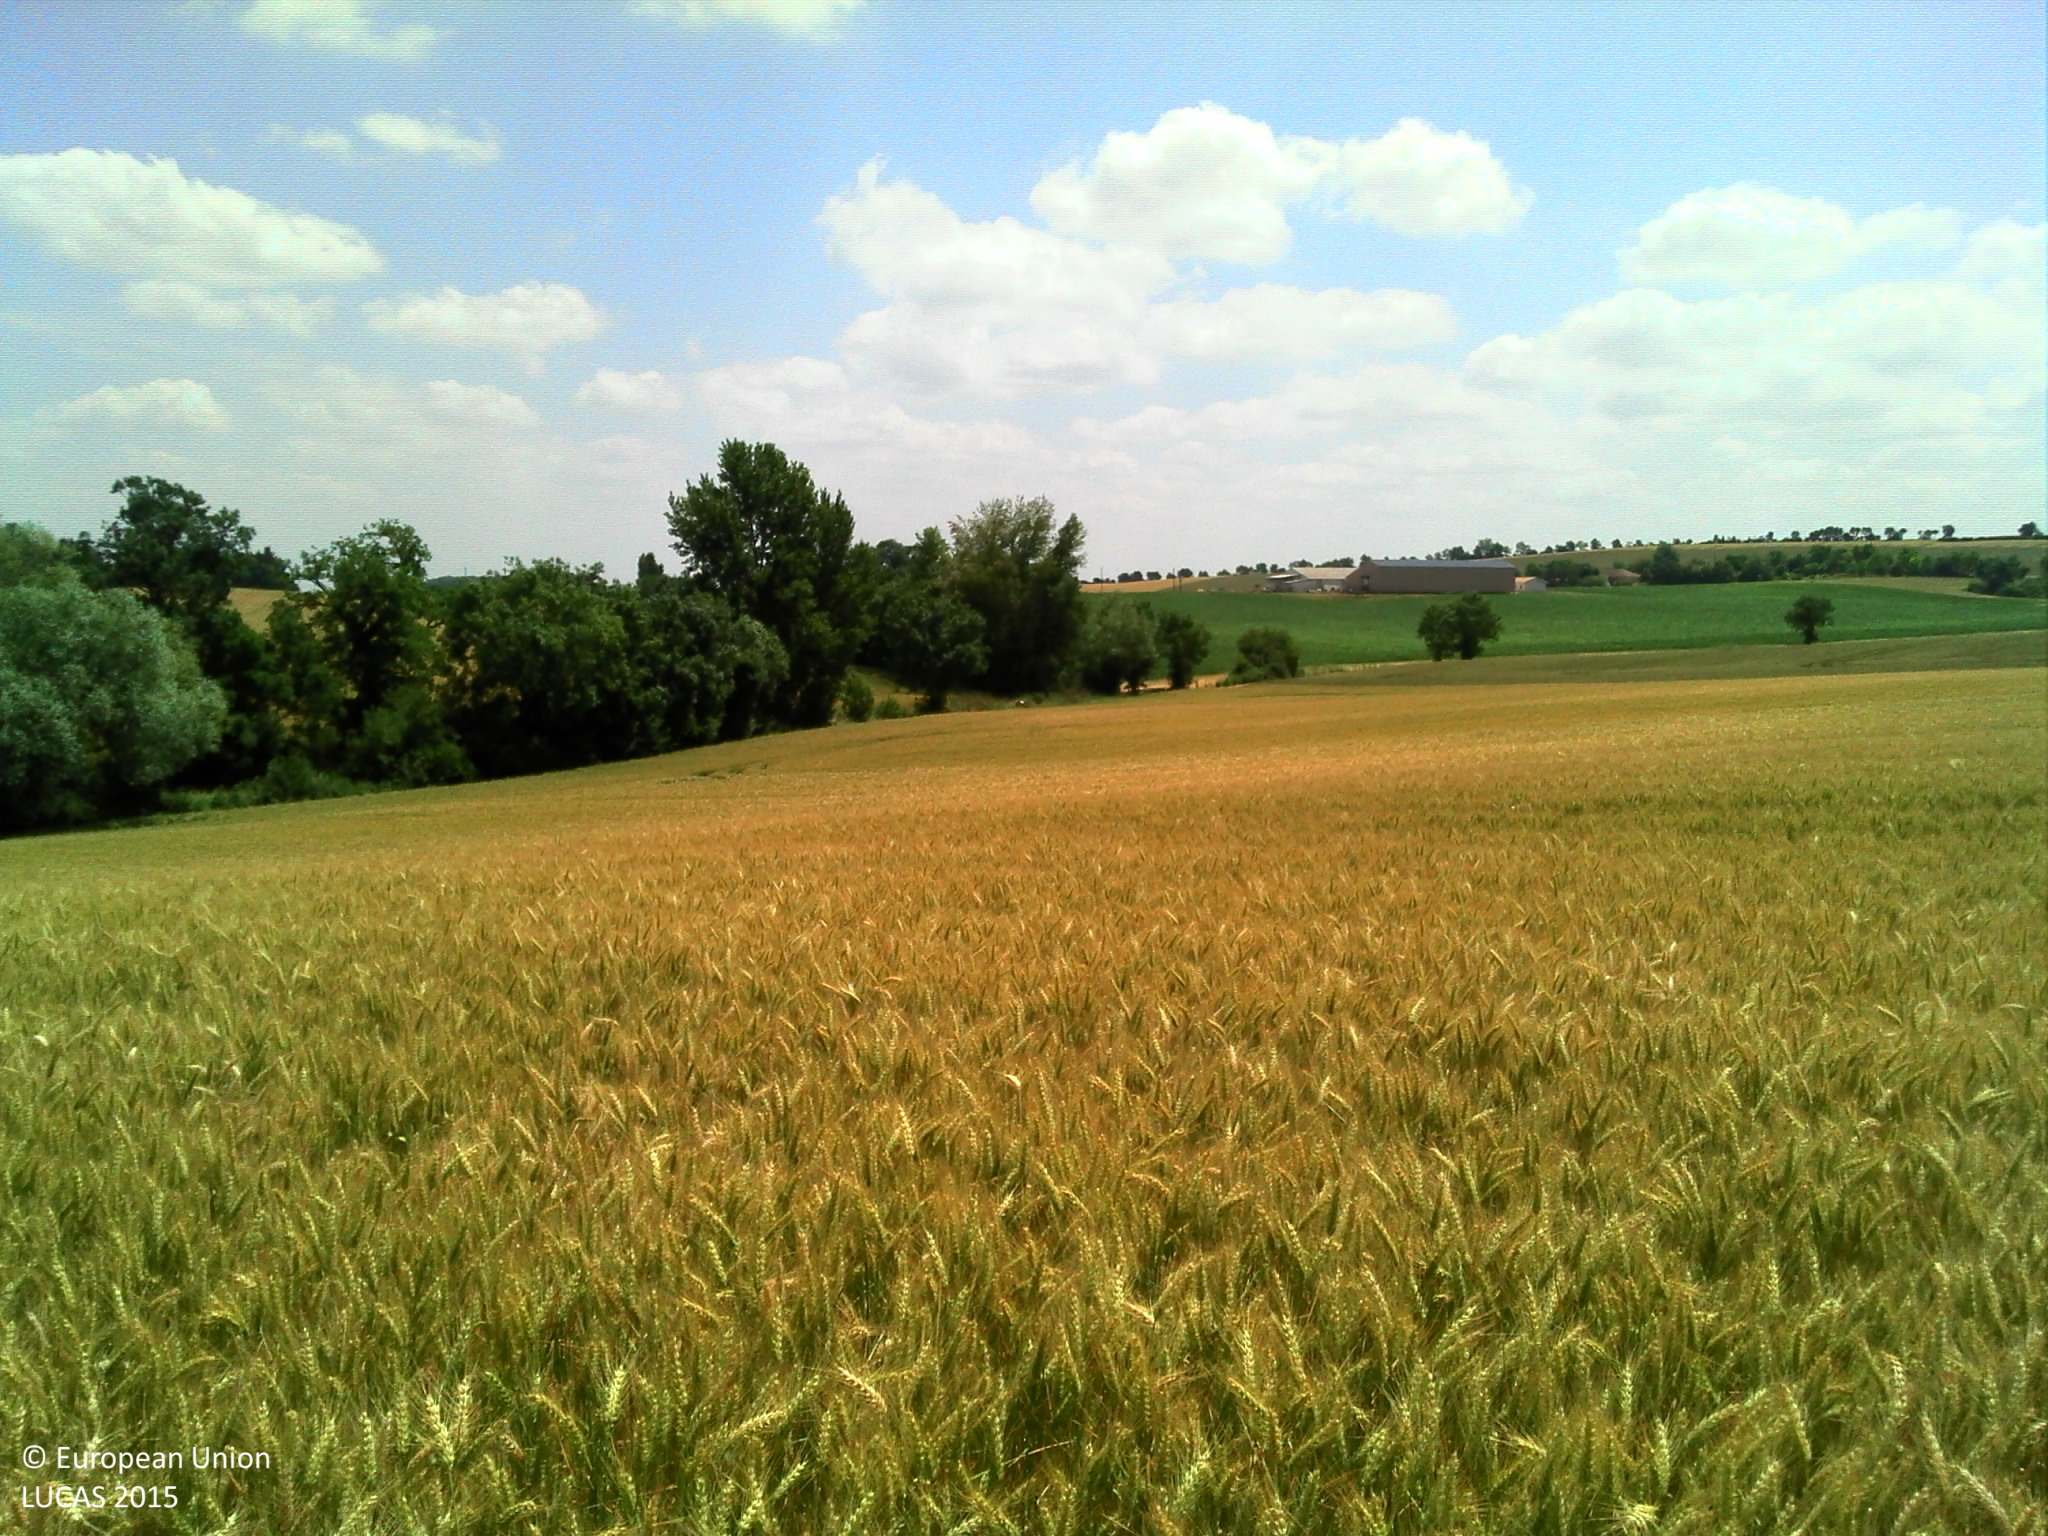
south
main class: Cropland
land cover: Durum wheat
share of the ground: > 75 %
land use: Agriculture (excluding fallow land and kitchen gardens)
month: June
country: FR
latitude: 43.7905
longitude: 0.7395
